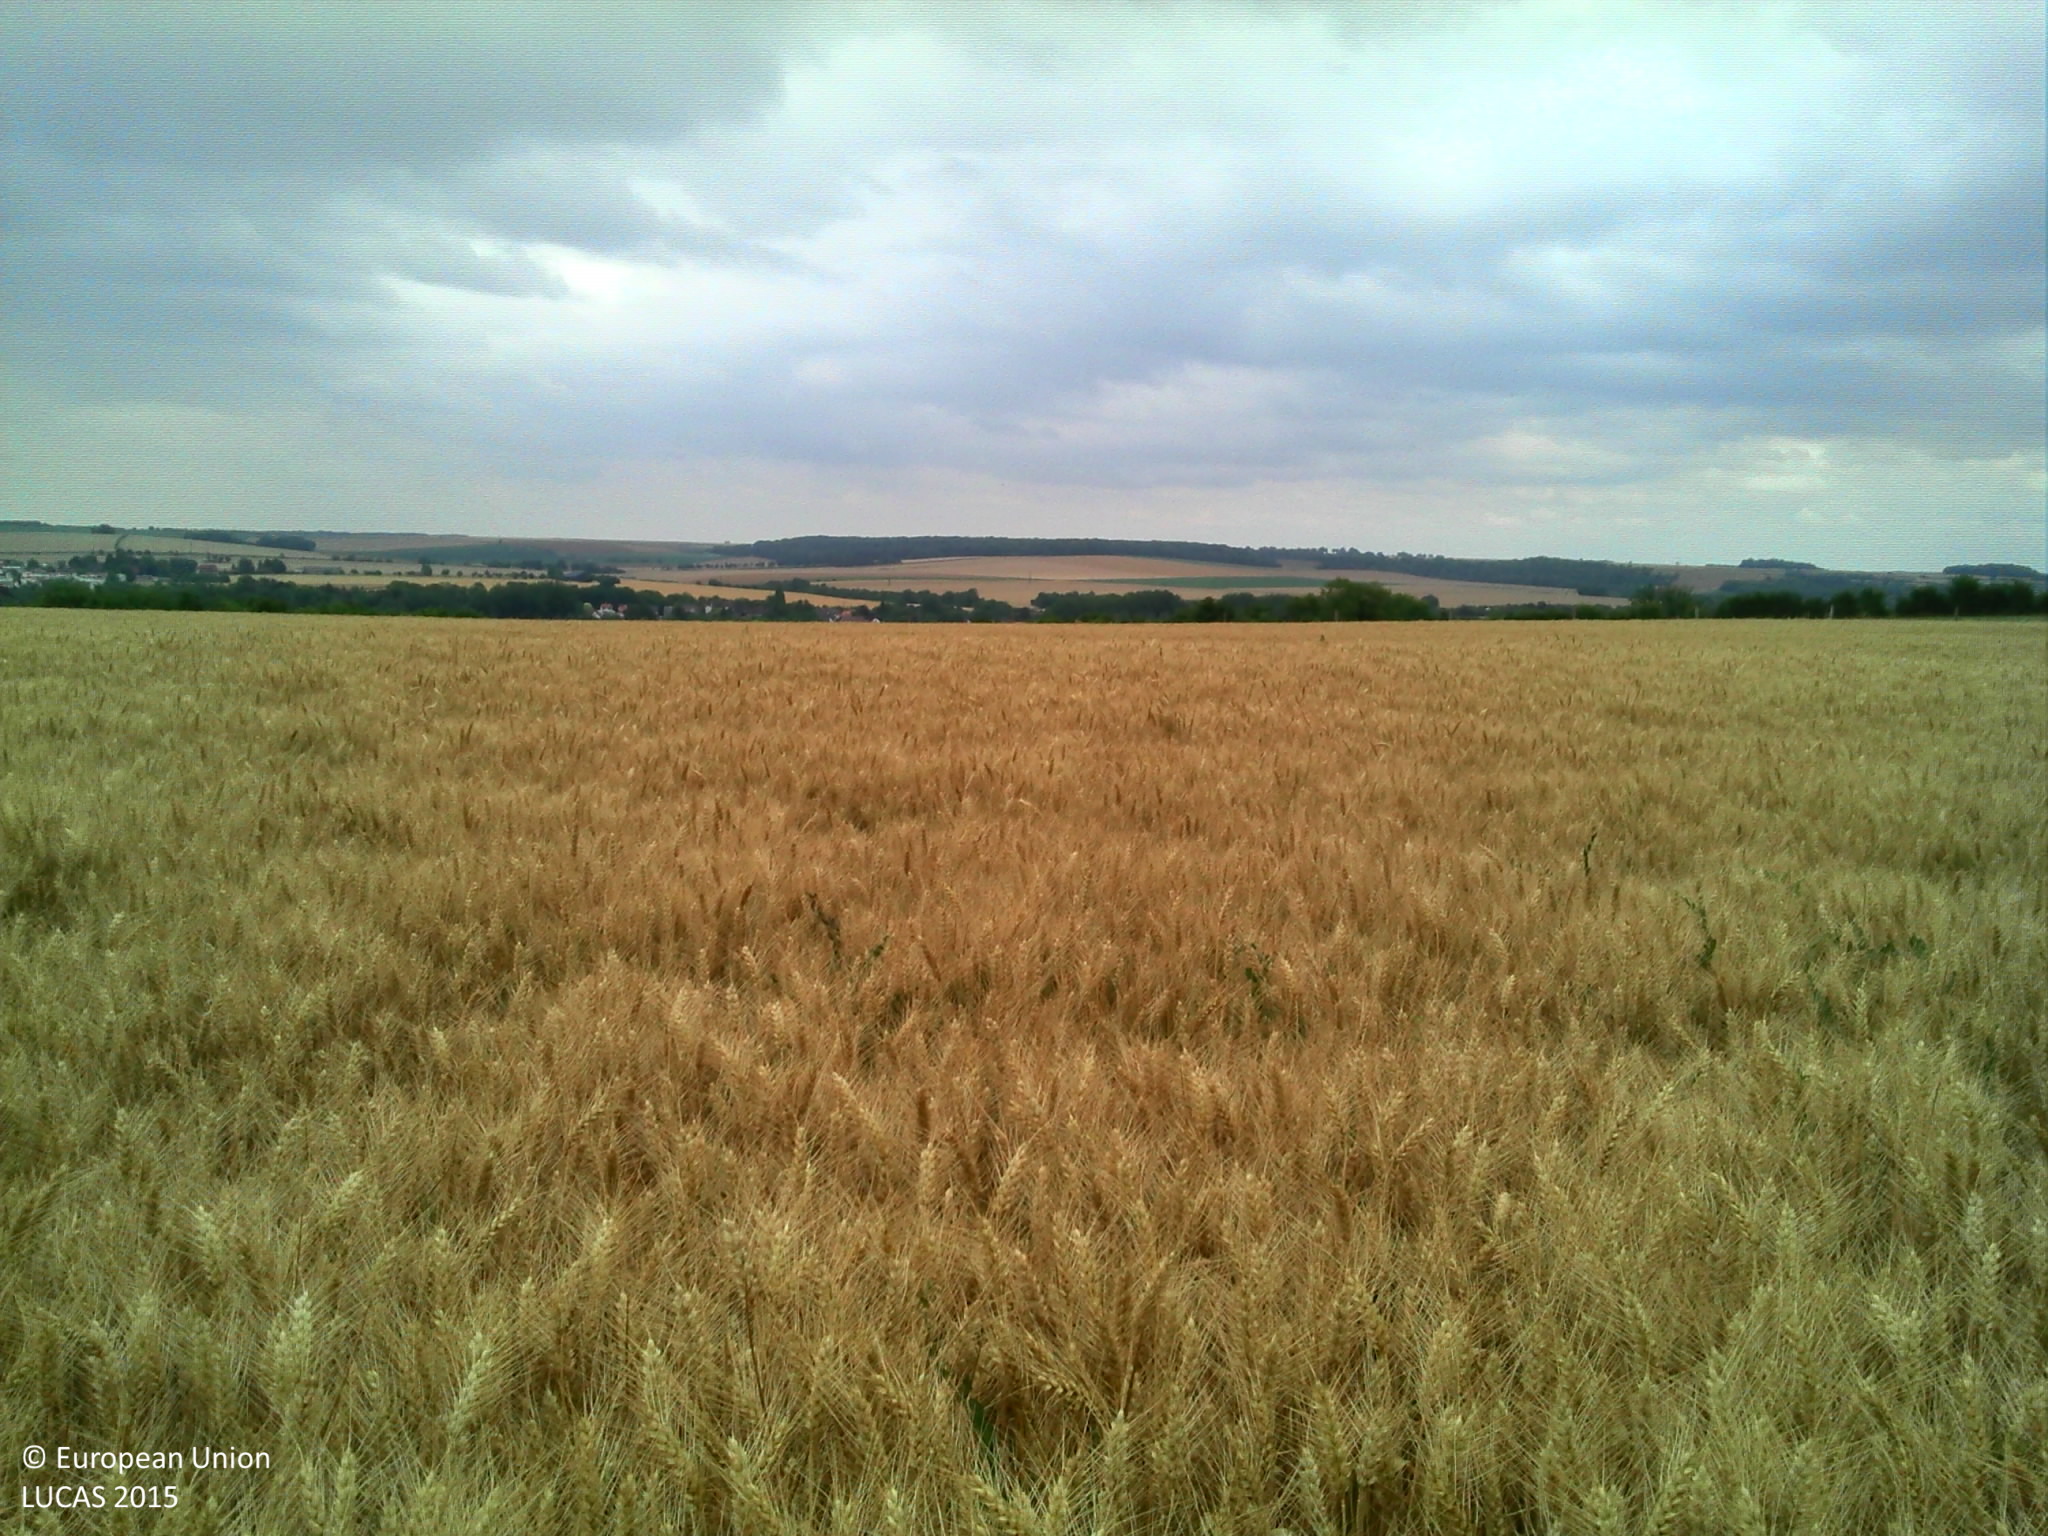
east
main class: Cropland
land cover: Common wheat
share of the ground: > 75 %
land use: Agriculture (excluding fallow land and kitchen gardens)
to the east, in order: Common wheat; Fences; Grassland without tree/shrub cover; Fences; Grassland without tree/shrub cover
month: July
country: FR
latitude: 49.8388
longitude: 2.3812
